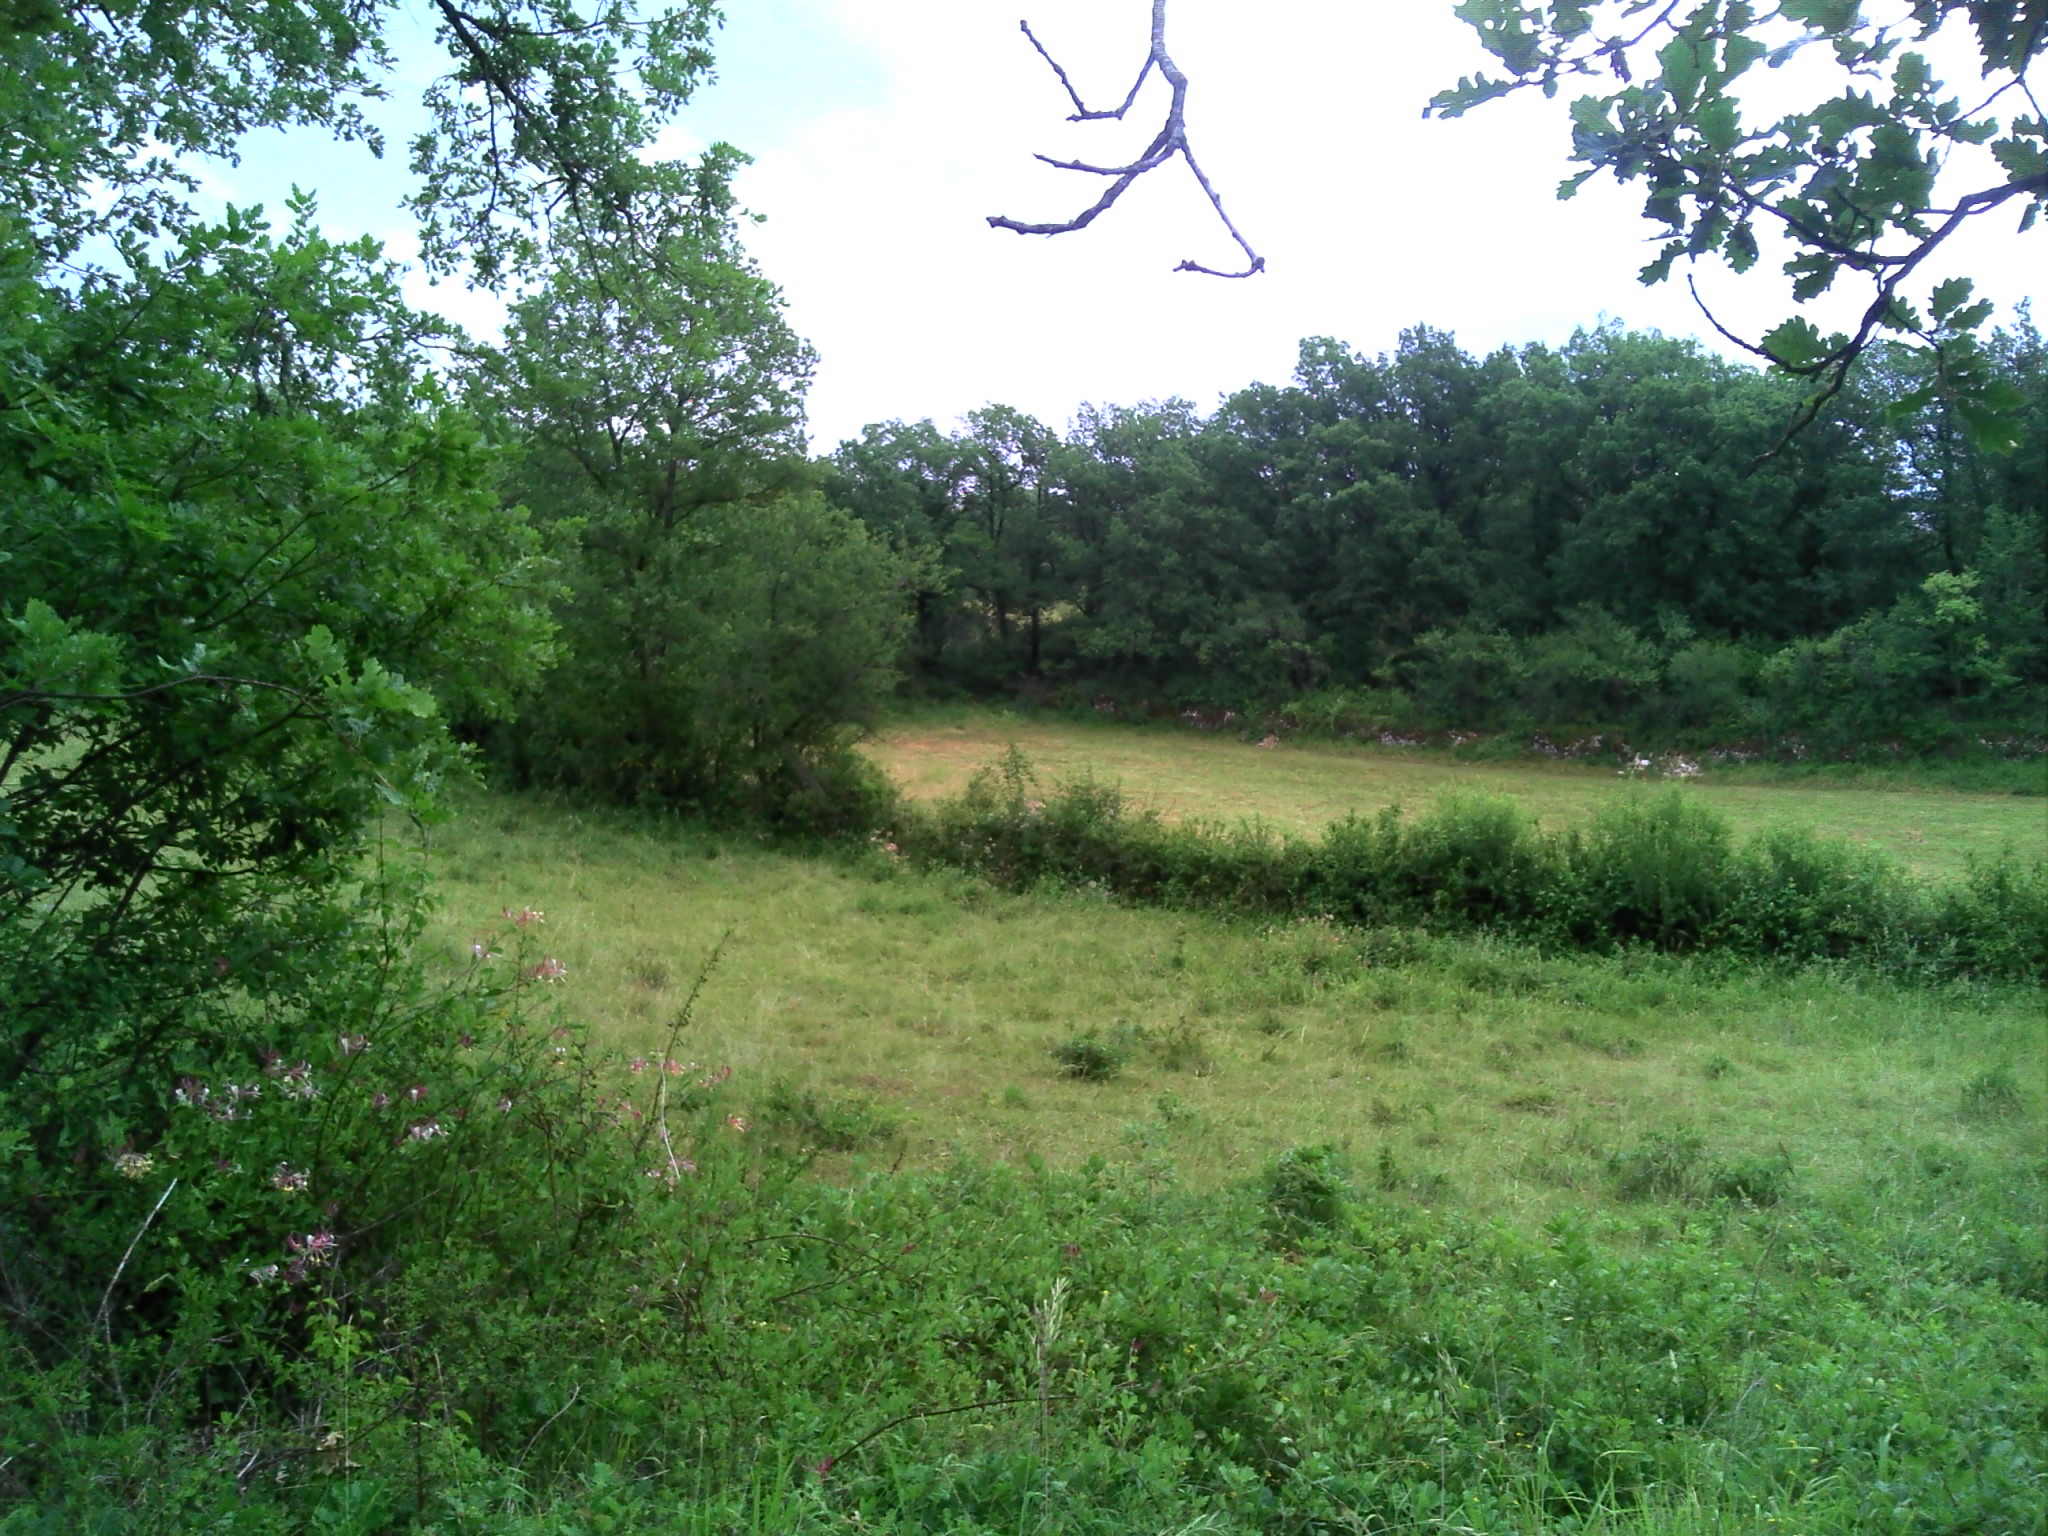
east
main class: Woodland
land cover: Broadleaved woodland
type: acidophilous oak and oak-birch forest
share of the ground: > 75 %
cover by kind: broadleaved forest trees 75 %, shrubs 20 %, herbaceous plants 5 %
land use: Forestry
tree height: > 5 m
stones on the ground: 25 - 50 %
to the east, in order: Broadleaved woodland; Spontaneously vegetated surfaces; Managed hedges; Grassland with sparse tree/shrub cover; Managed hedges; Dry stone walls; Grassland without tree/shrub cover; Broadleaved woodland; Dry stone walls; Fences; Grassland with sparse tree/shrub cover; Broadleaved woodland; Dry stone walls; Fences; Grassland with sparse tree/shrub cover; Broadleaved woodland; Dry stone walls; Fences; Managed hedges; Grassland with sparse tree/shrub cover
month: June
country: FR
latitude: 44.4082
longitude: 1.8254
